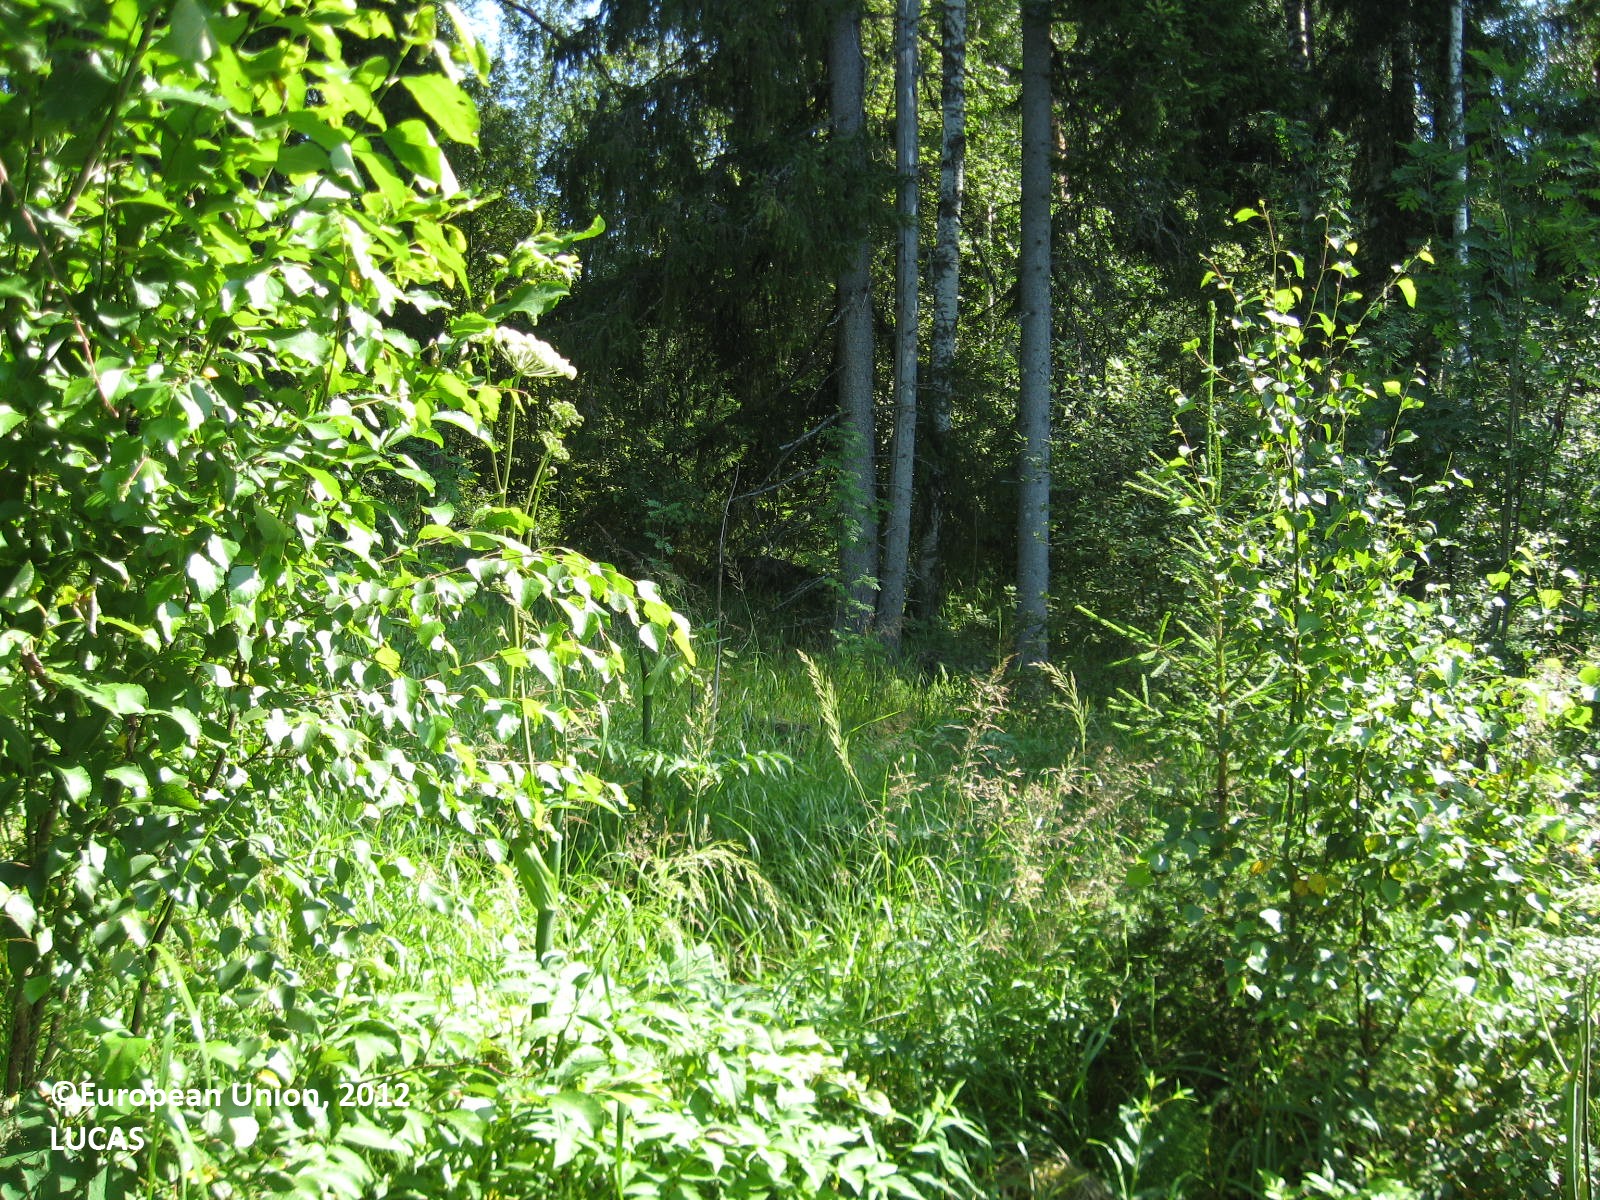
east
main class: Woodland
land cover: Other mixed woodland
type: boreal forest
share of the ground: > 75 %
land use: Forestry
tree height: > 5 m
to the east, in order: Other mixed woodland; Temporary grasslands; Spruce dominated mixed woodland; Temporary grasslands; Grass margins; Ditches and canals; Grass margins; Paved roads, cycling and walking lanes; Grass margins; Ditches and canals; Grassland without tree/shrub cover
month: July
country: FI
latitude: 61.9277
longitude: 22.8857
